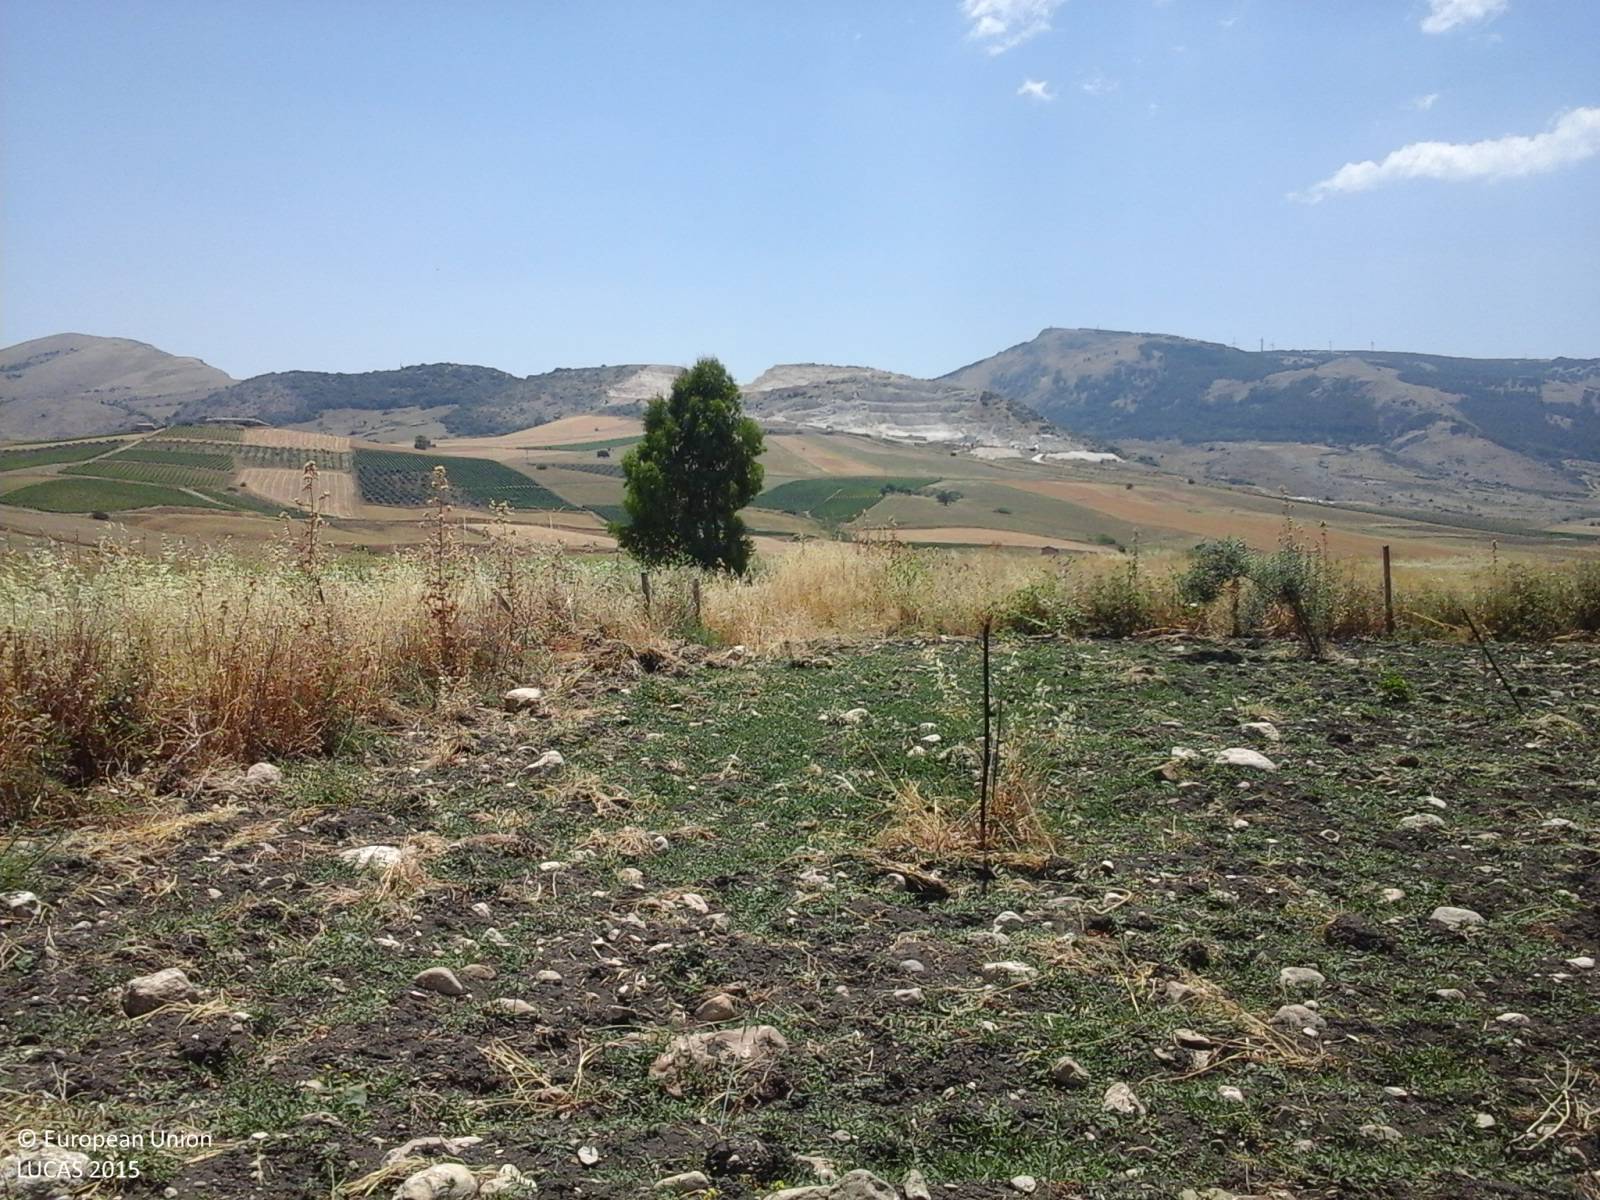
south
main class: Cropland
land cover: Olive groves
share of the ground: 10 - 25 %
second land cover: Other bare soil
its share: > 75 %
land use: Agriculture (excluding fallow land and kitchen gardens)
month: July
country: IT
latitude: 37.6579
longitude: 13.1840
